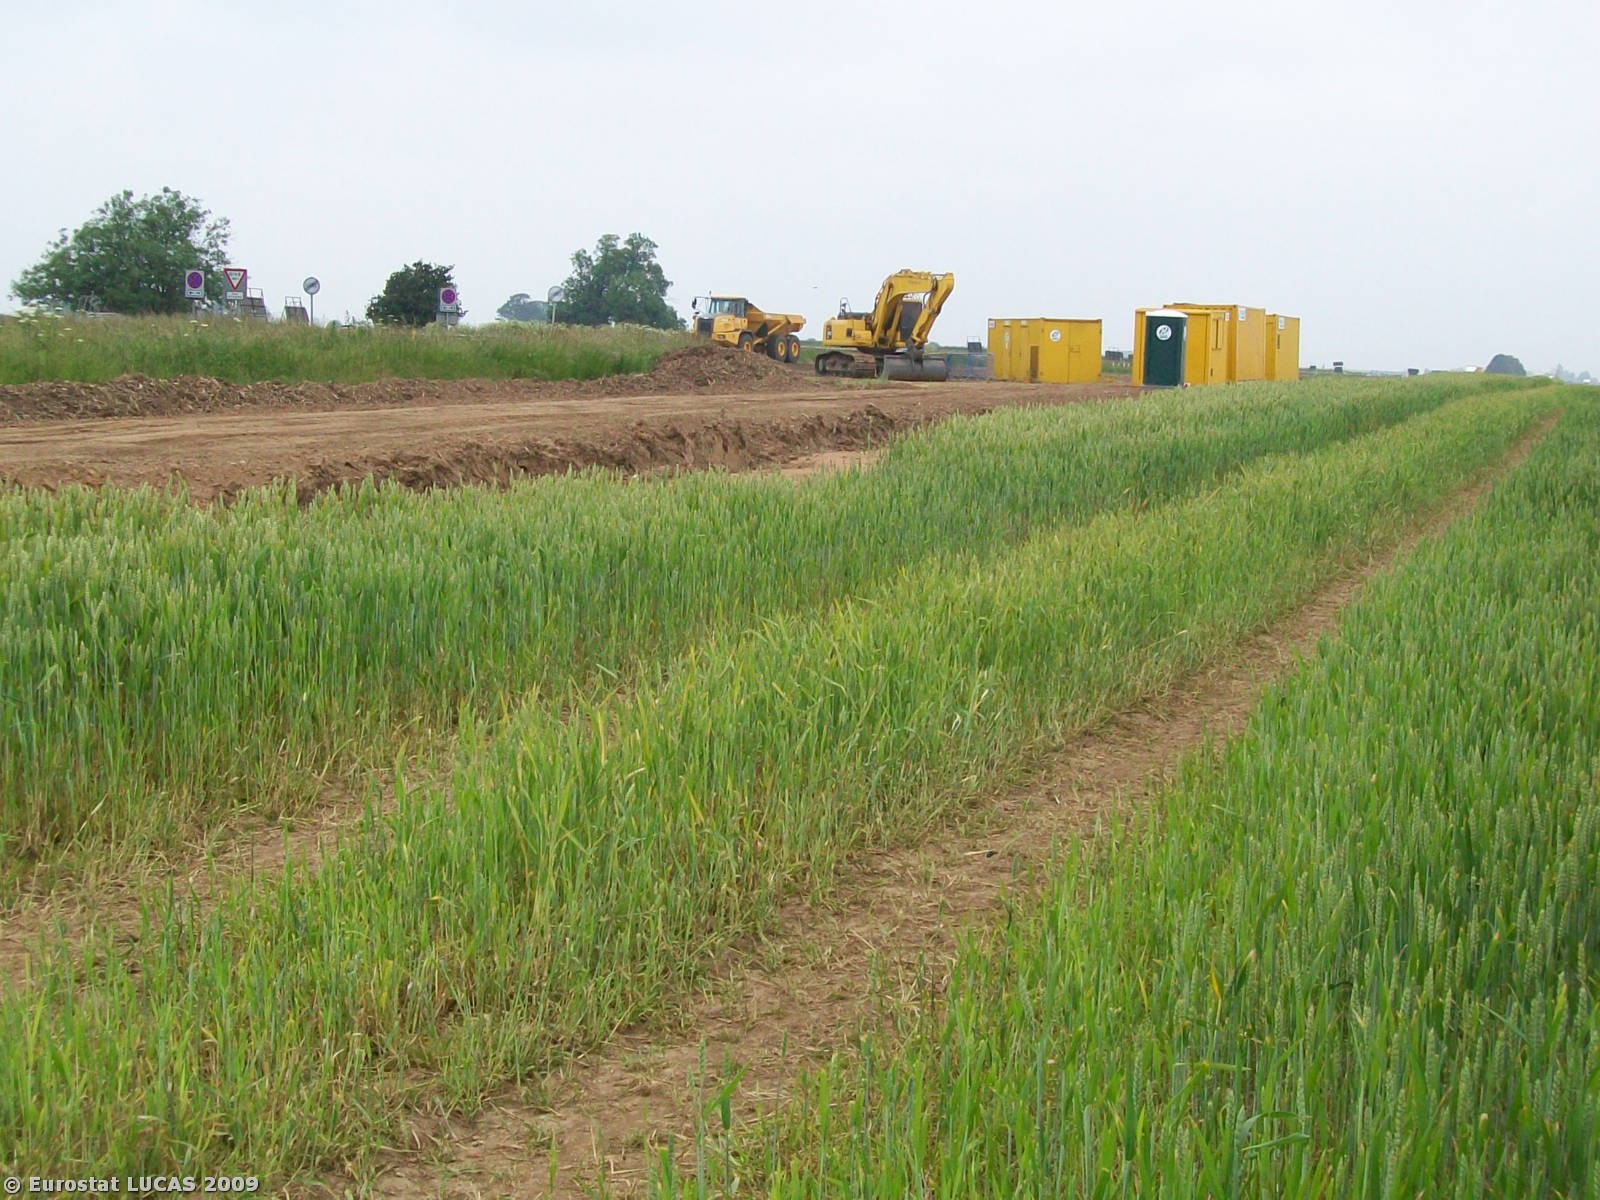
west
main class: Cropland
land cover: Common wheat
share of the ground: < 10 %
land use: Agriculture (excluding fallow land and kitchen gardens)
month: June
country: GB
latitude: 54.1995
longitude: -1.4687
